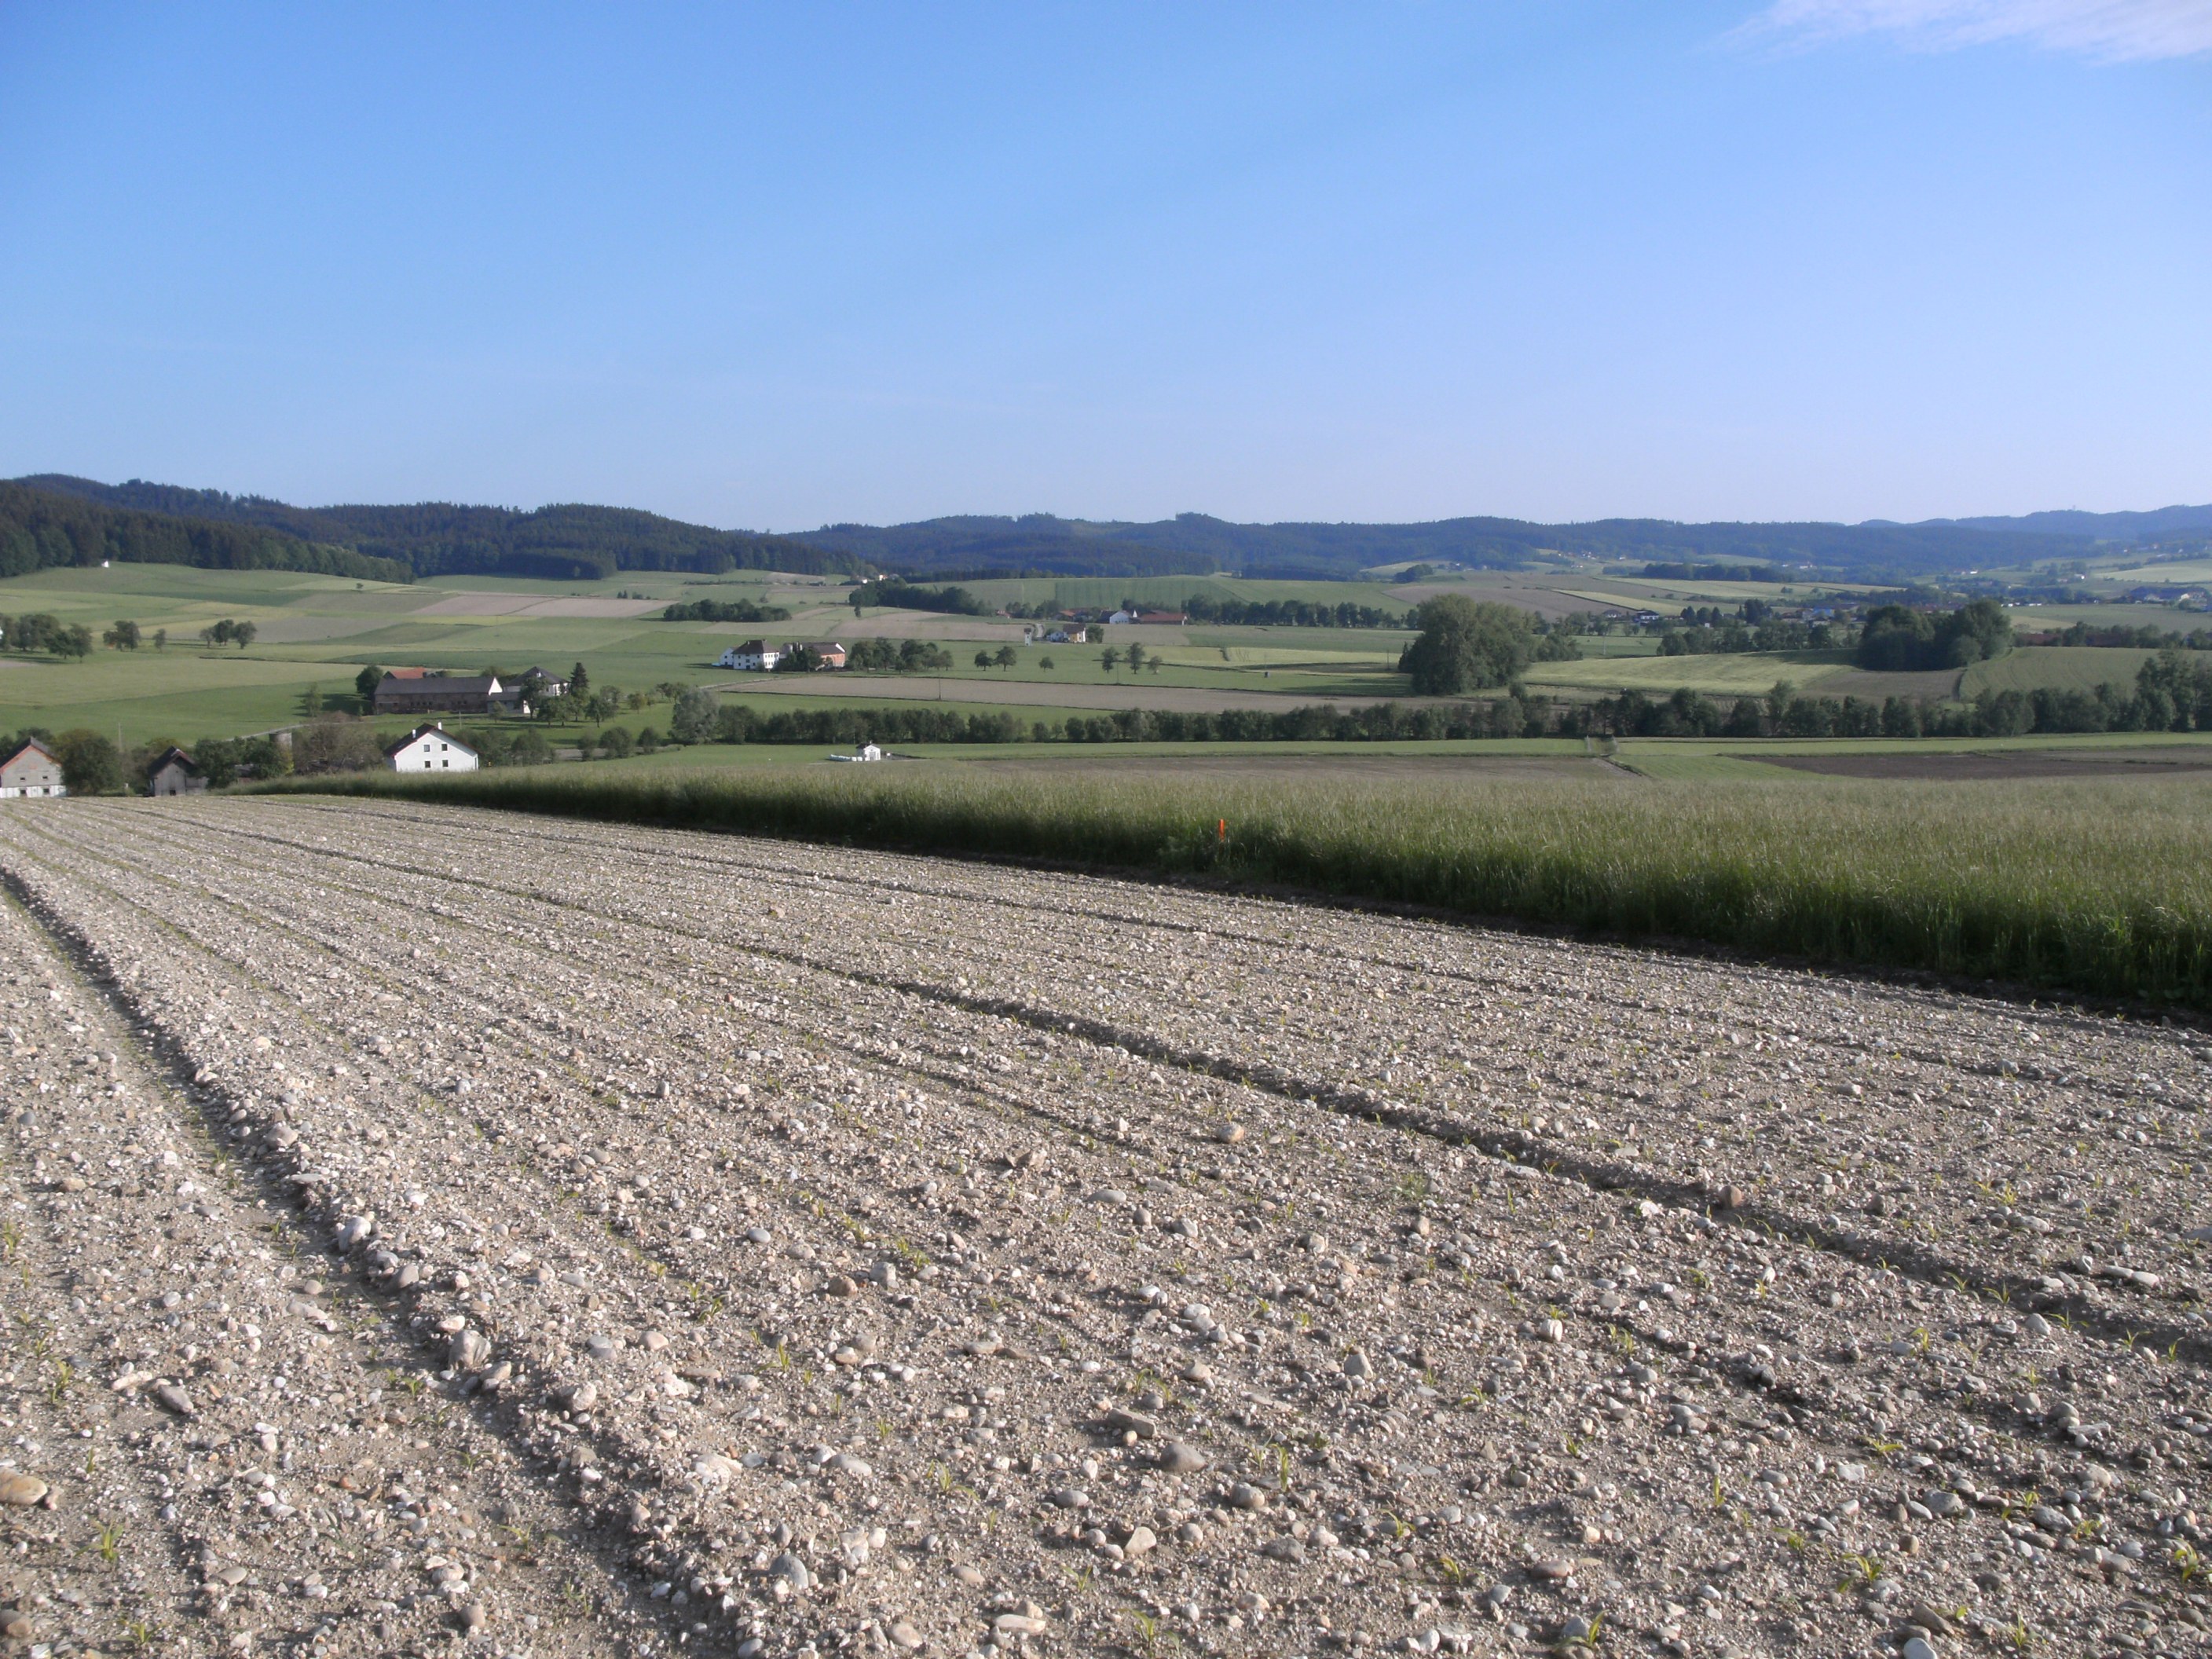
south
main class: Cropland
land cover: Maize
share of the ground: < 10 %
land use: Agriculture (excluding fallow land and kitchen gardens)
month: May
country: AT
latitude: 48.1651
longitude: 13.5892
